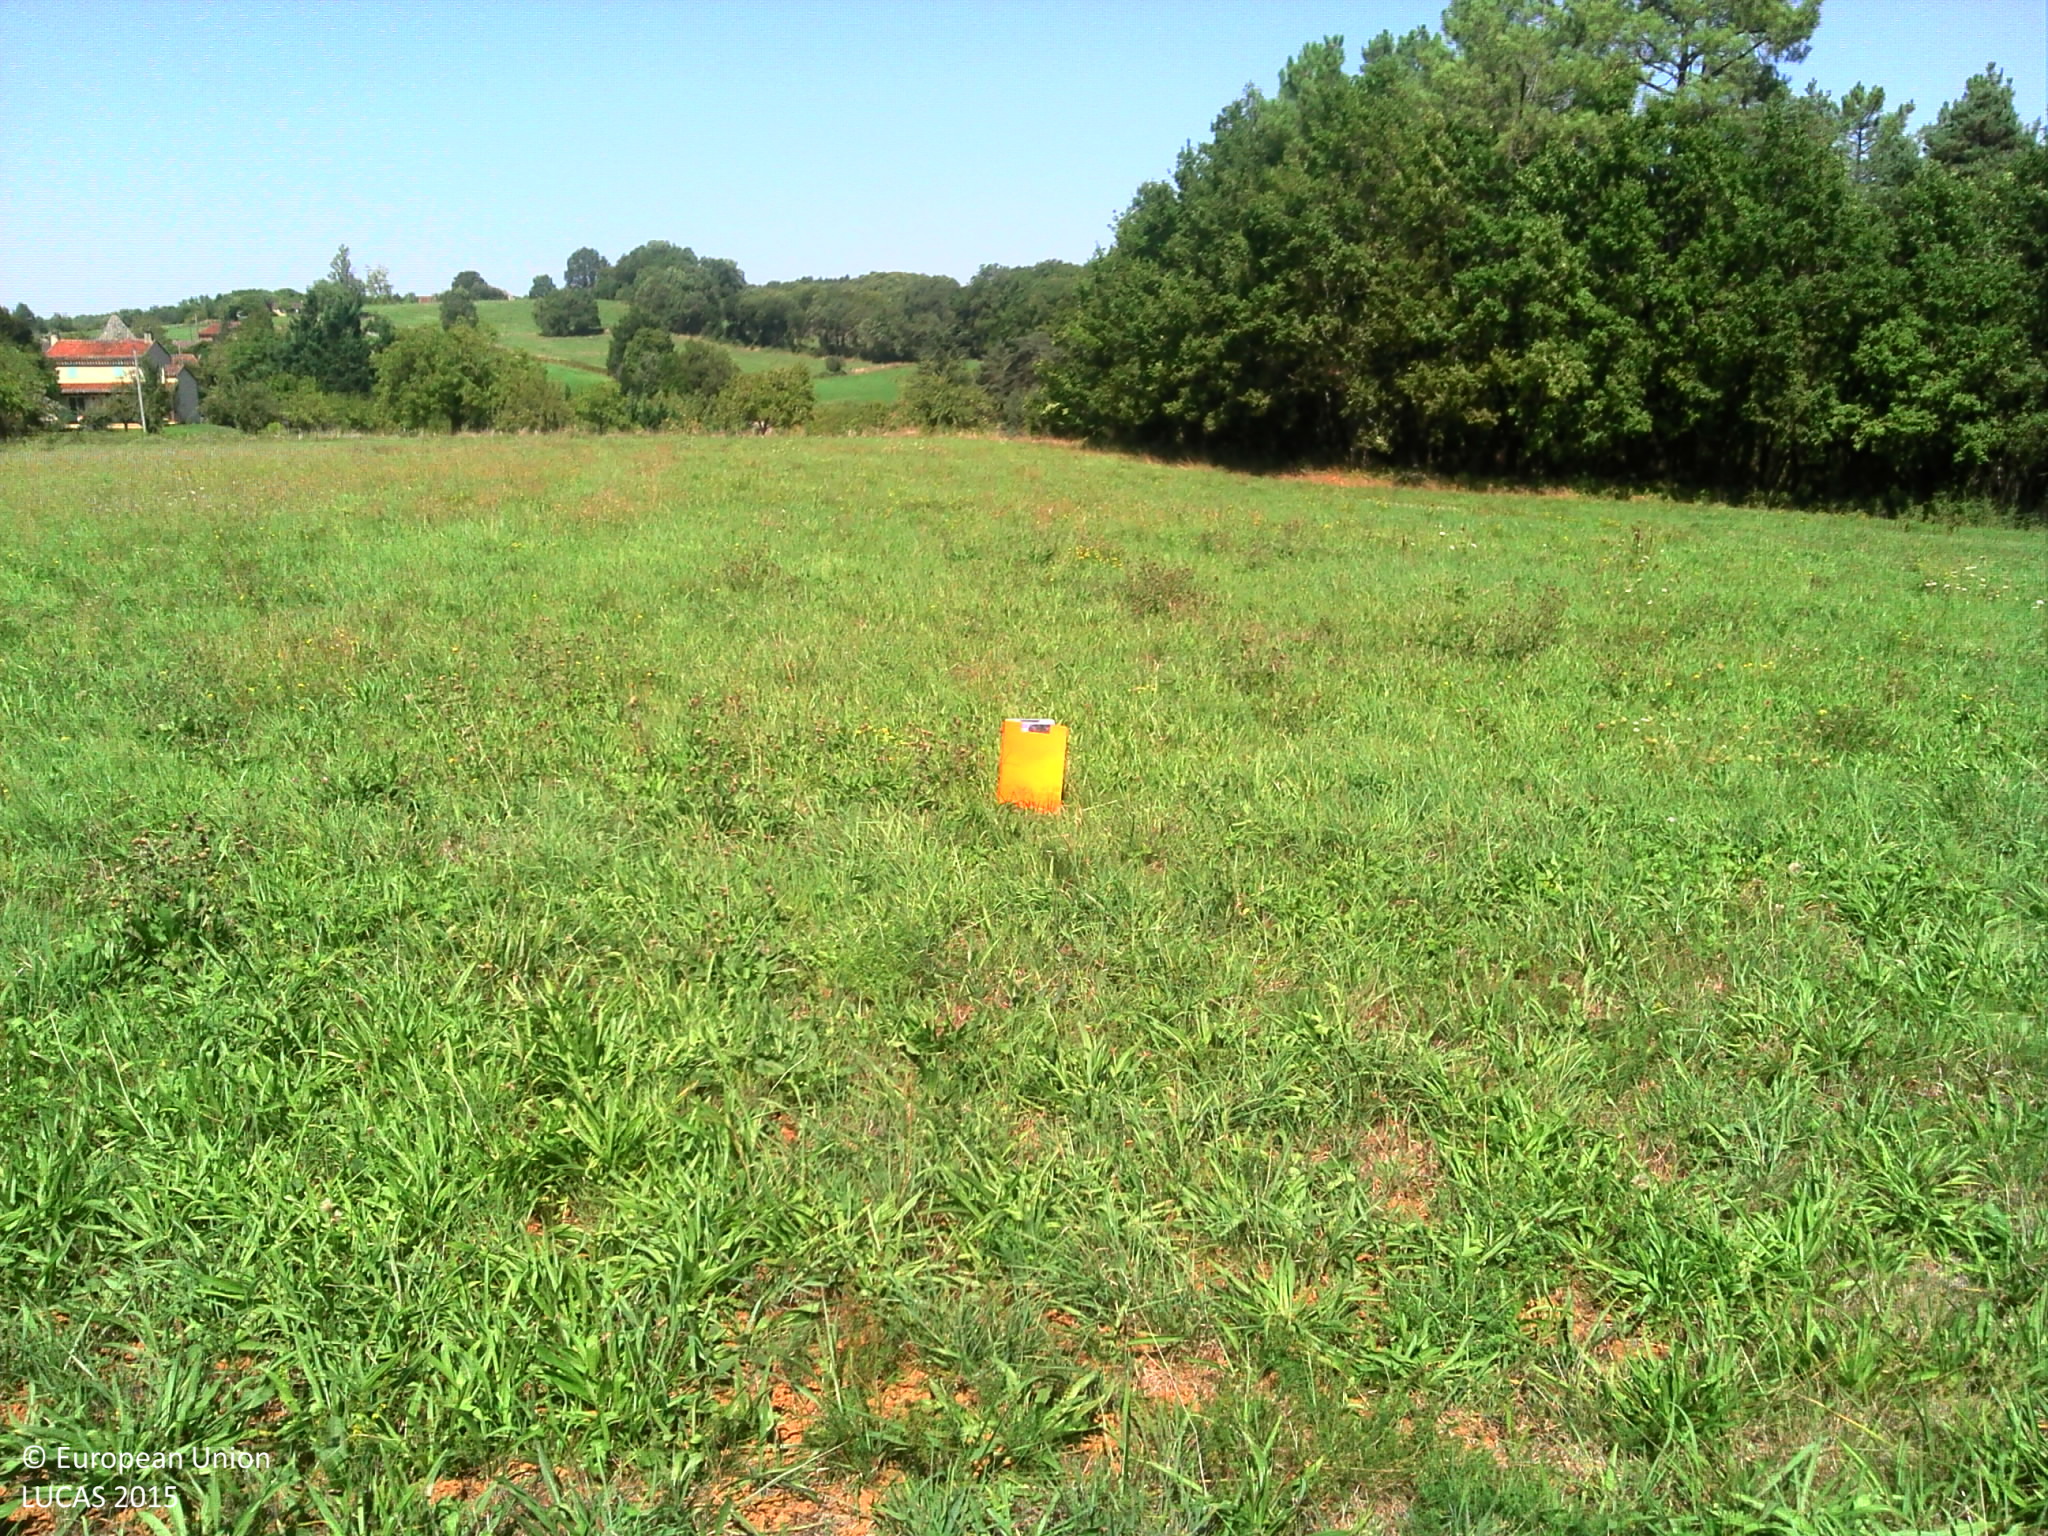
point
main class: Grassland
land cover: Grassland without tree/shrub cover
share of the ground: > 75 %
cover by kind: herbaceous plants 100 %
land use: Agriculture (excluding fallow land and kitchen gardens)
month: August
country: FR
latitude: 44.5739
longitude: 1.1937
